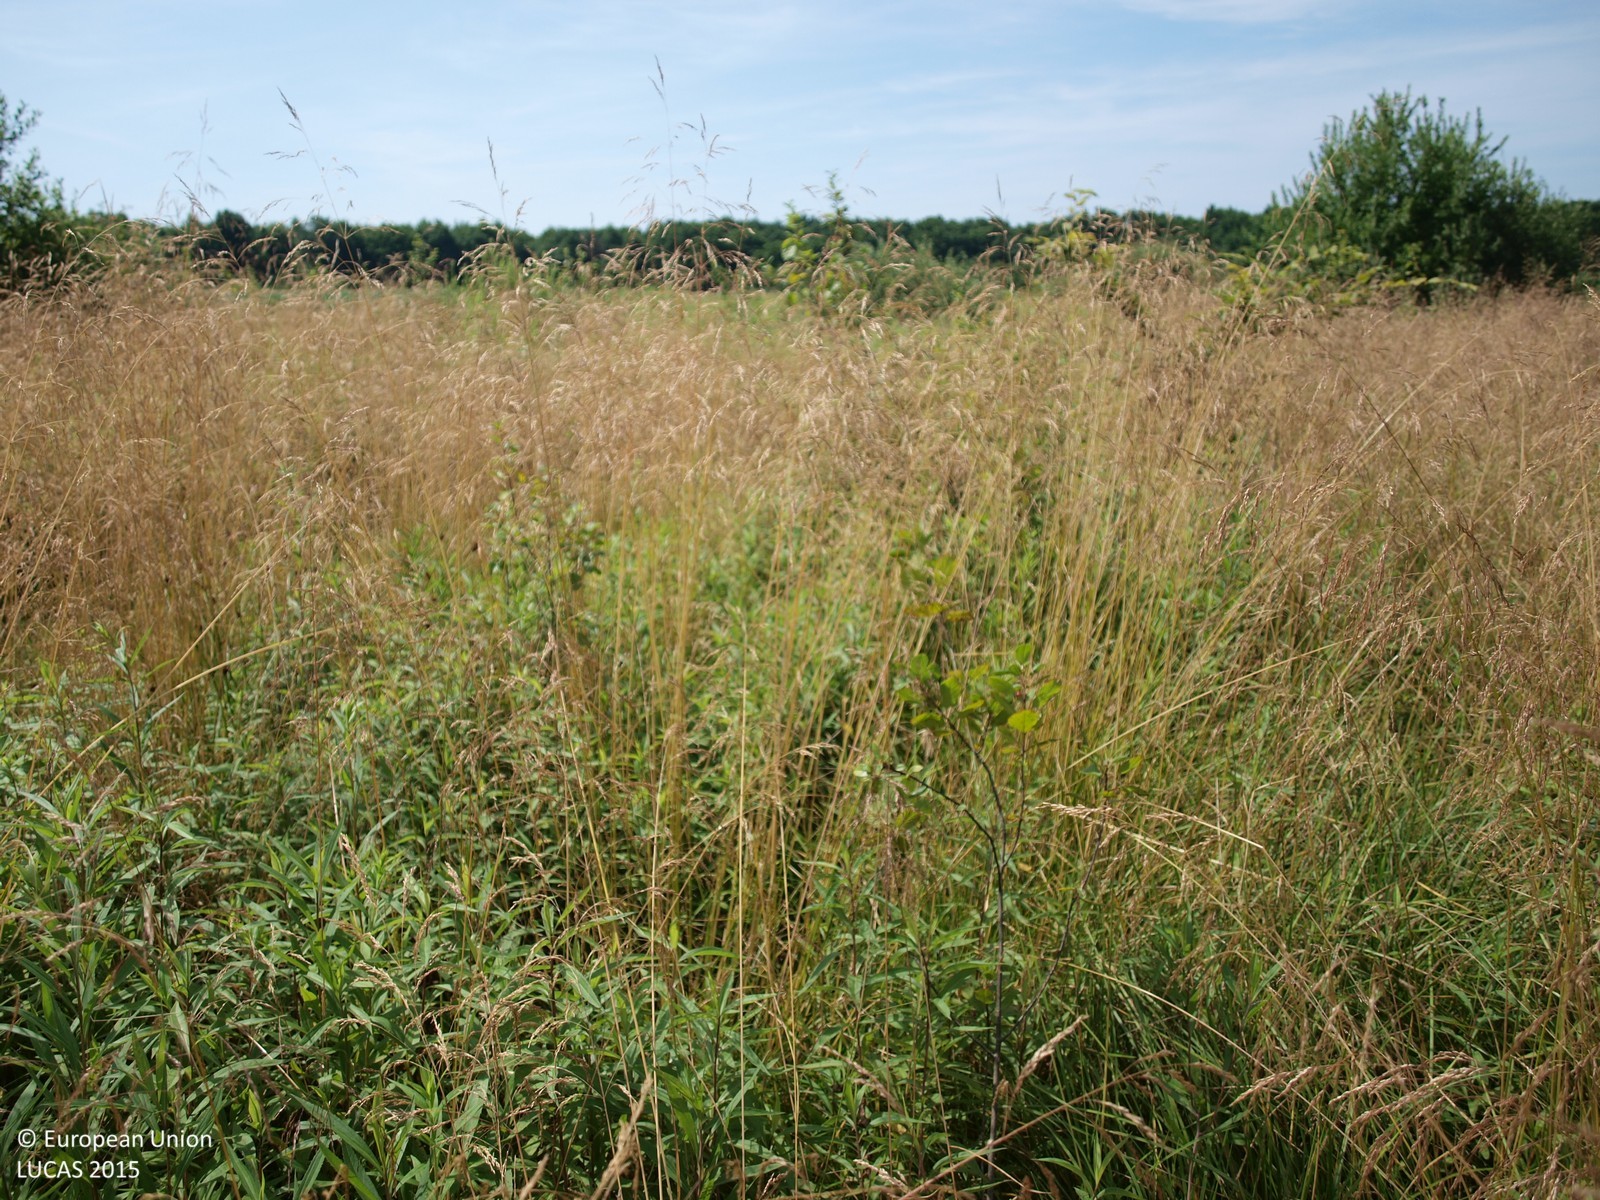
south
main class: Grassland
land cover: Grassland with sparse tree/shrub cover
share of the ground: > 75 %
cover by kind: herbaceous plants 90 %, broadleaved forest trees 5 %, shrubs 5 %
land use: Fallow land
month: July
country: HR
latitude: 45.7399
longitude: 15.8452
